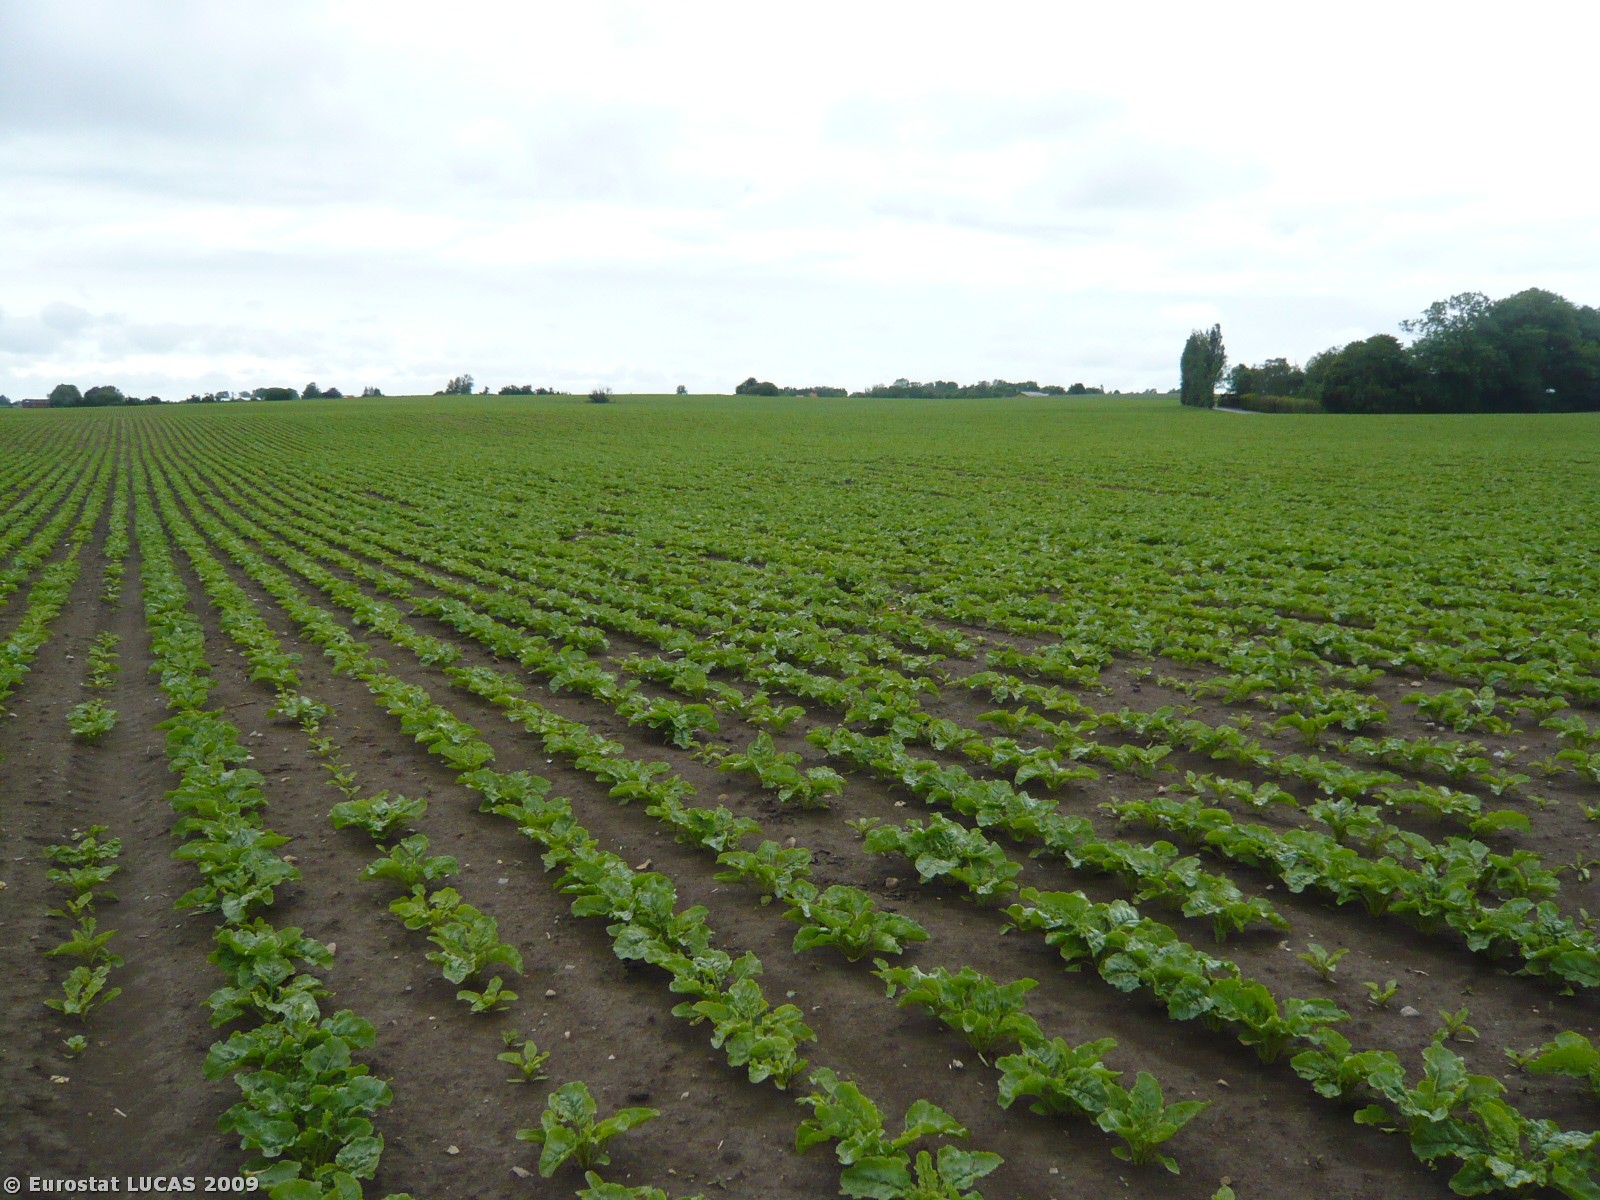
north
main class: Cropland
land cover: Sugar beet
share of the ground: 25 - 50 %
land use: Agriculture (excluding fallow land and kitchen gardens)
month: June
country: DK
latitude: 54.8231
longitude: 12.0377
